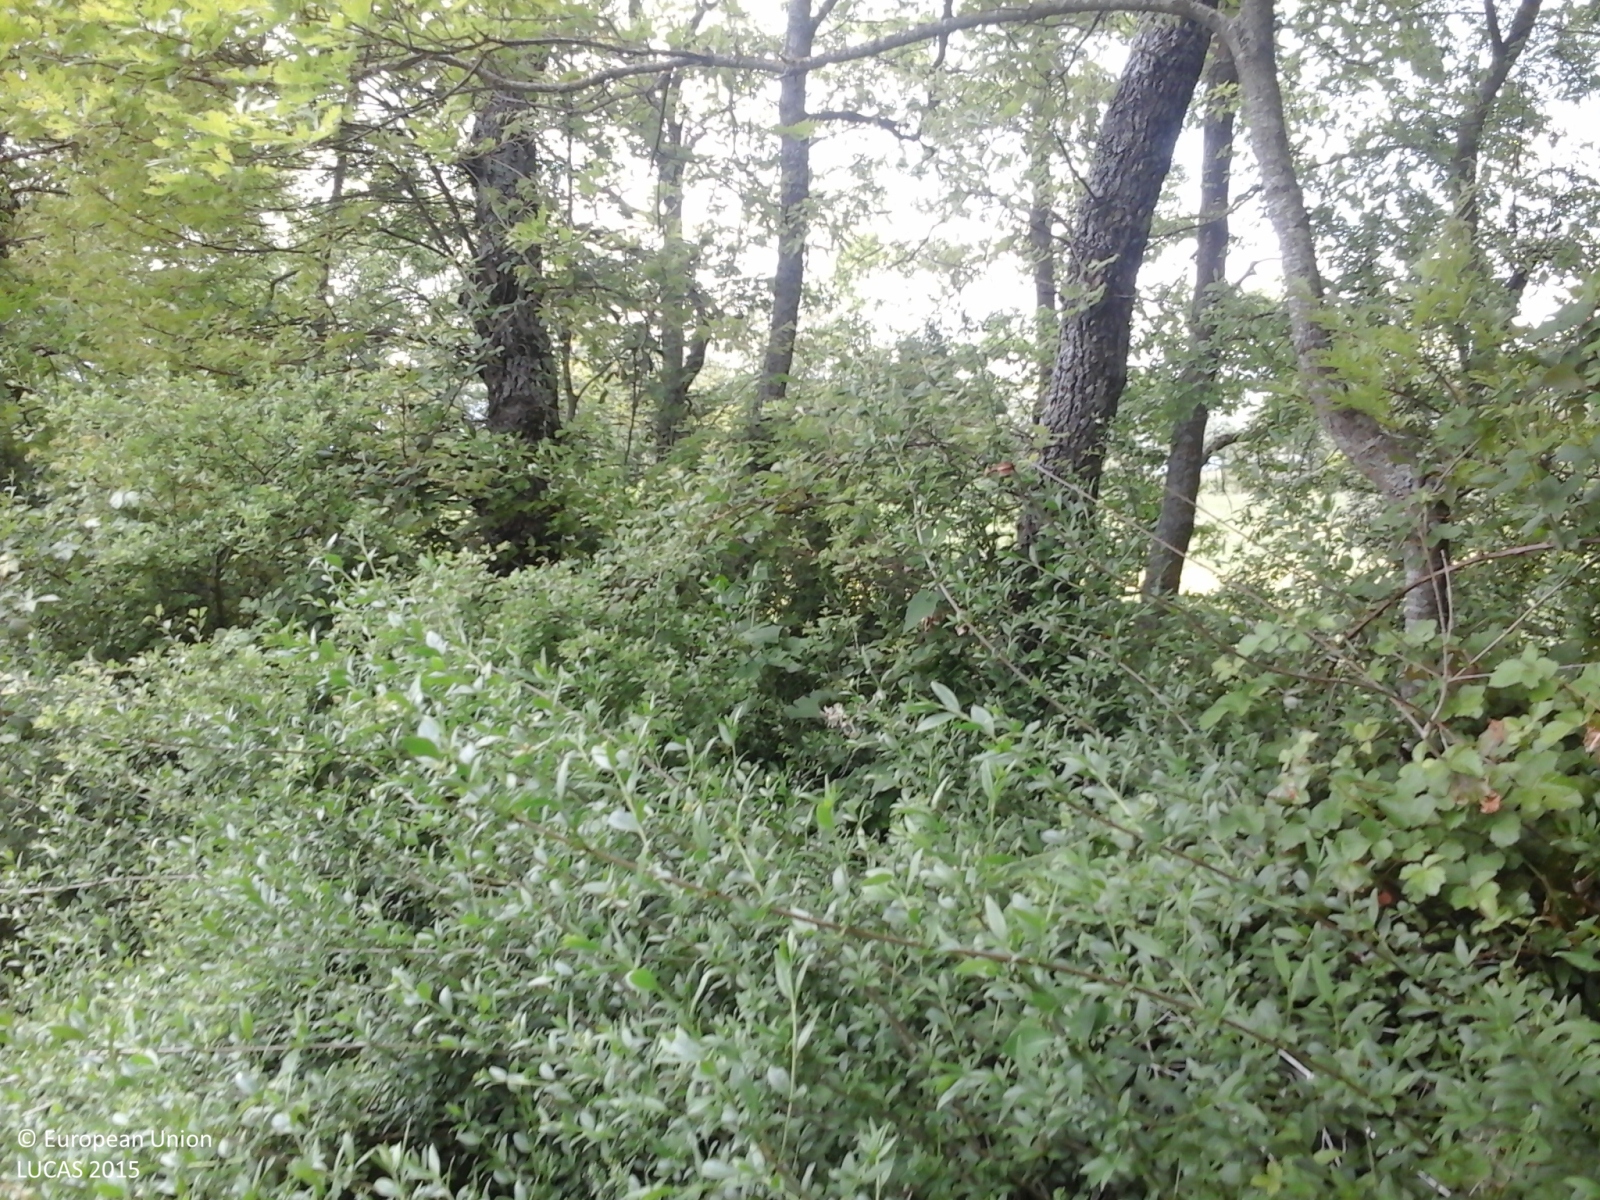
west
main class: Woodland
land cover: Broadleaved woodland
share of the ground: > 75 %
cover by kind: broadleaved forest trees 80 %, shrubs 20 %
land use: Forestry
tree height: > 5 m
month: May
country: IT
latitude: 41.3864
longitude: 14.7067
